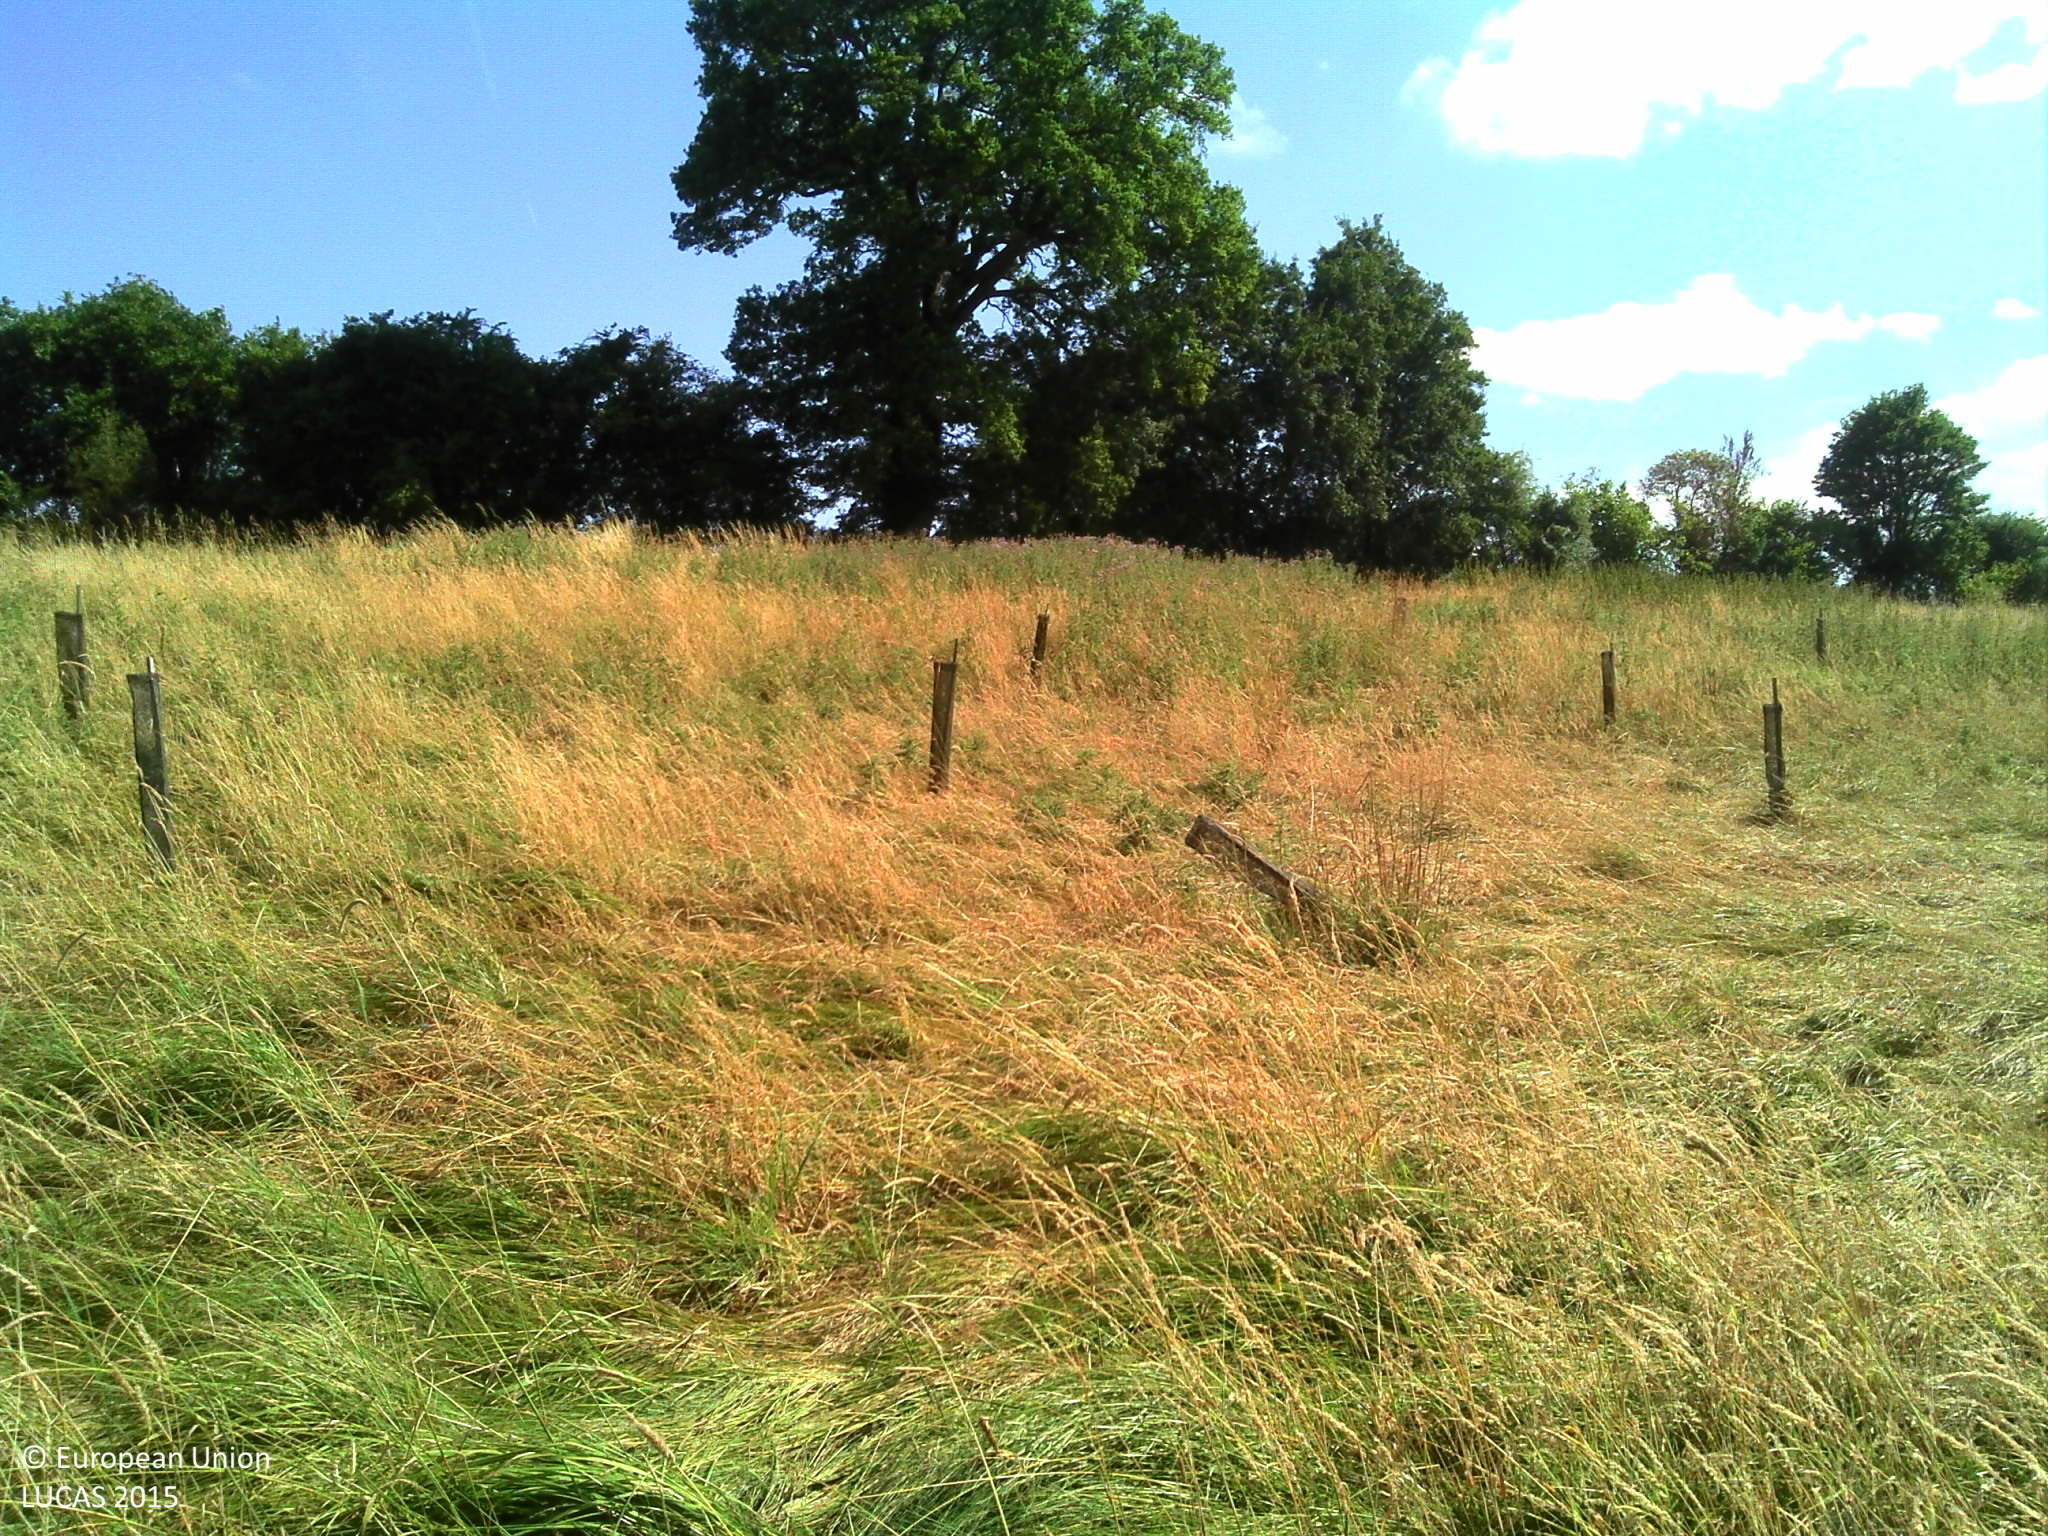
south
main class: Grassland
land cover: Grassland with sparse tree/shrub cover
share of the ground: > 75 %
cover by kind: herbaceous plants 95 %, broadleaved forest trees 5 %
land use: Agriculture (excluding fallow land and kitchen gardens)
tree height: > 5 m
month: July
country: FR
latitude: 48.2596
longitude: 0.8596
